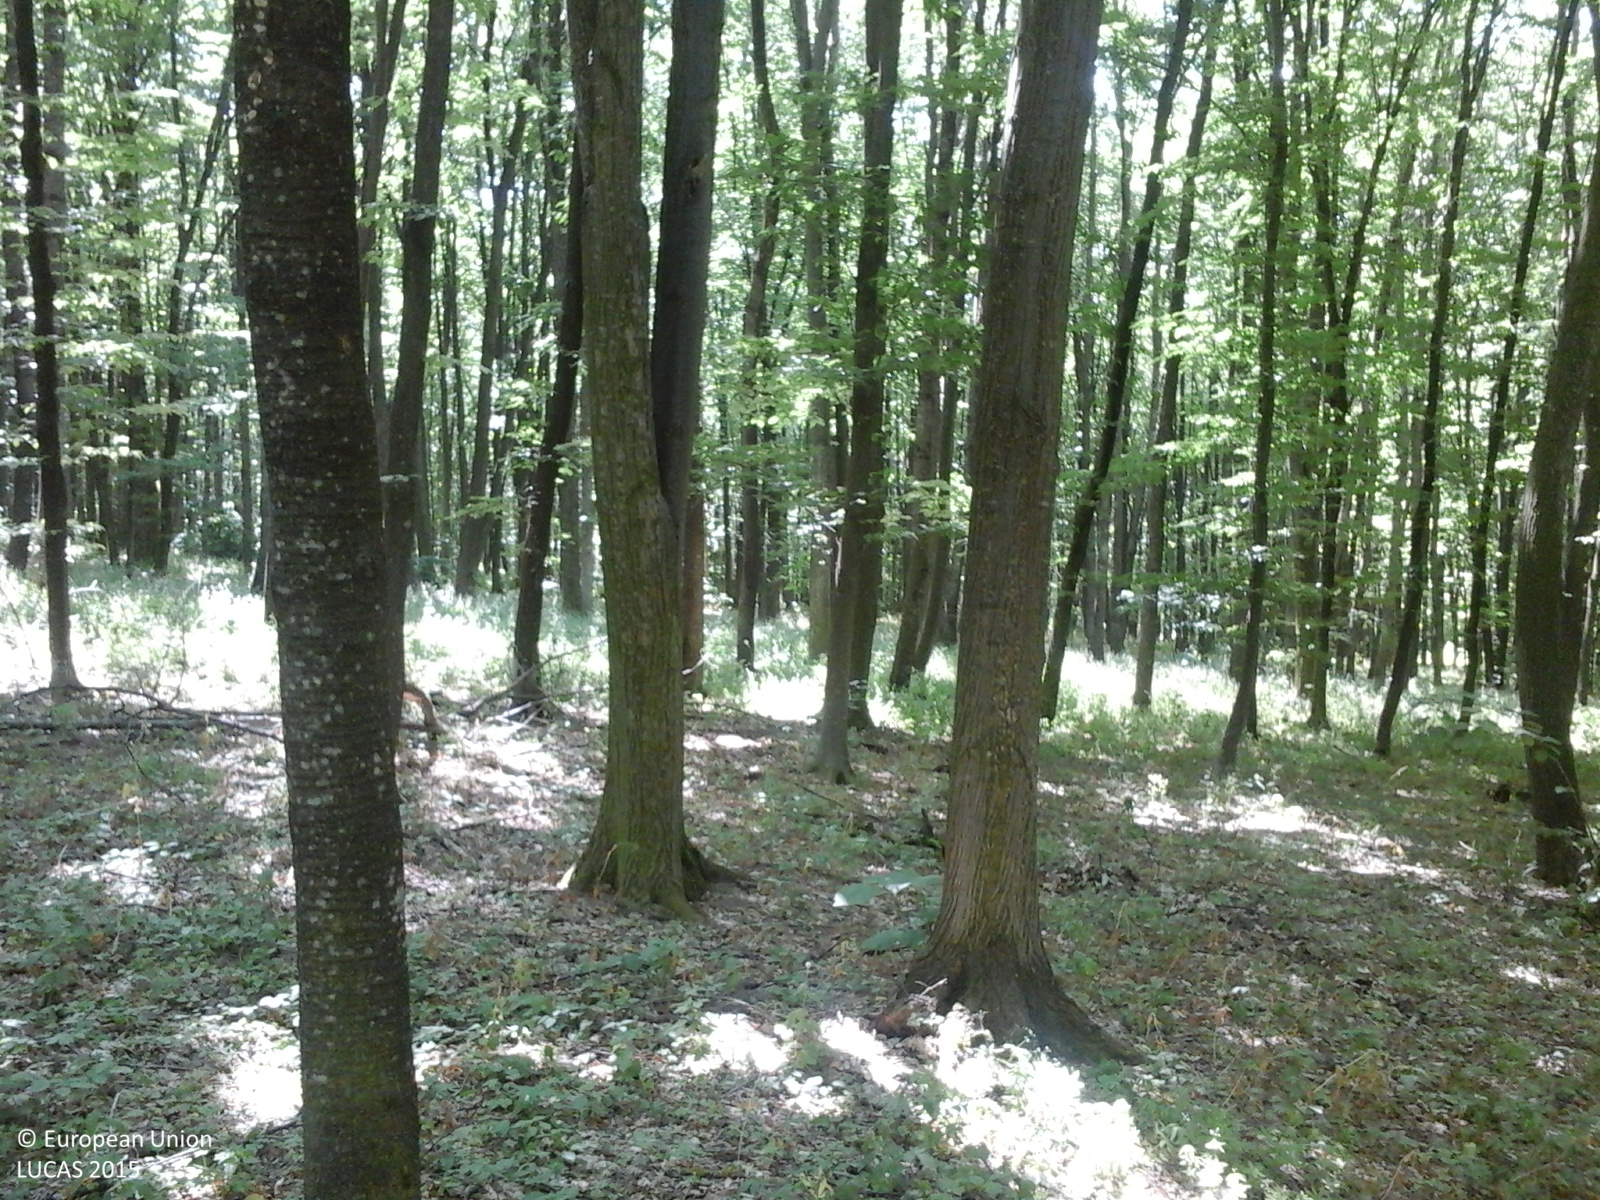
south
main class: Woodland
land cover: Broadleaved woodland
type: beech forest
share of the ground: > 75 %
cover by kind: broadleaved forest trees 100 %
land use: Forestry
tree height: > 5 m
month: June
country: RO
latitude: 46.6913
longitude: 26.9780
